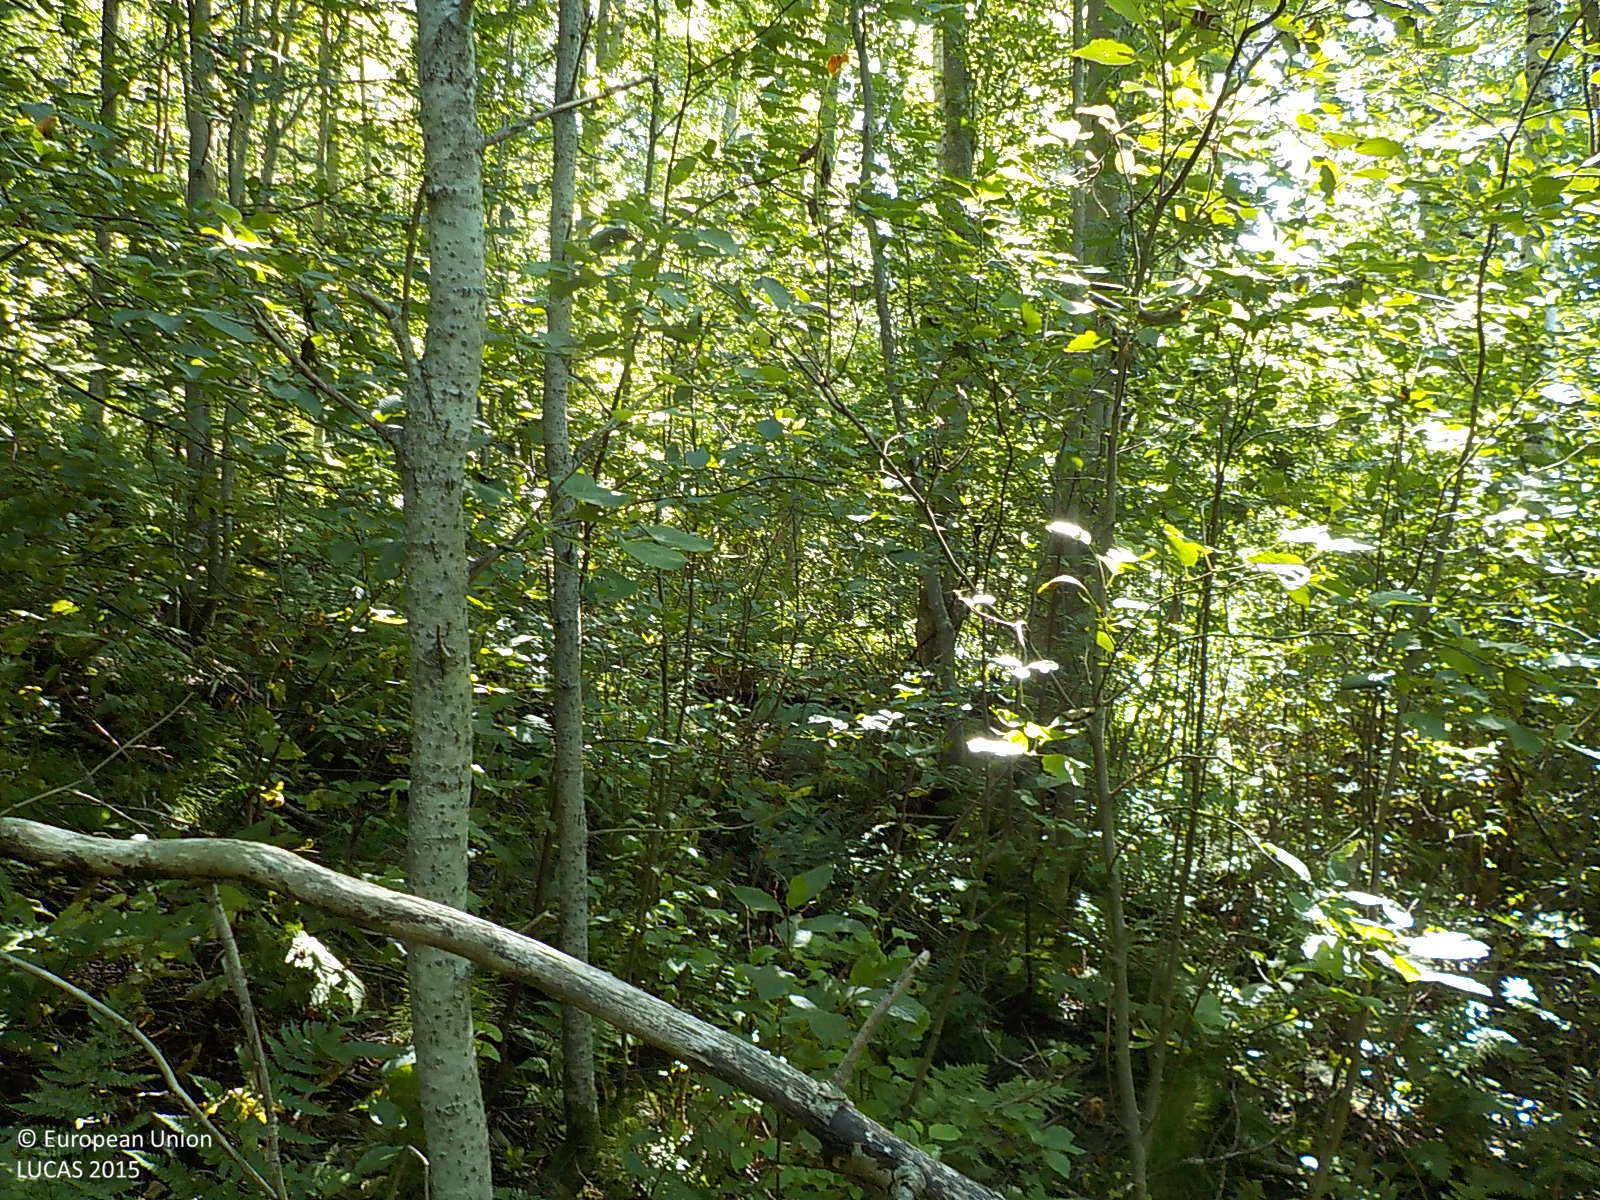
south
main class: Woodland
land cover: Broadleaved woodland
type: hemiboreal forest and nemoral coniferous forest and mixed broadleaved-coniferous forest
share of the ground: > 75 %
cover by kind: broadleaved forest trees 95 %, herbaceous plants 5 %
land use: Forestry
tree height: > 5 m
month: August
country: SE
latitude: 63.3251
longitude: 18.6630
